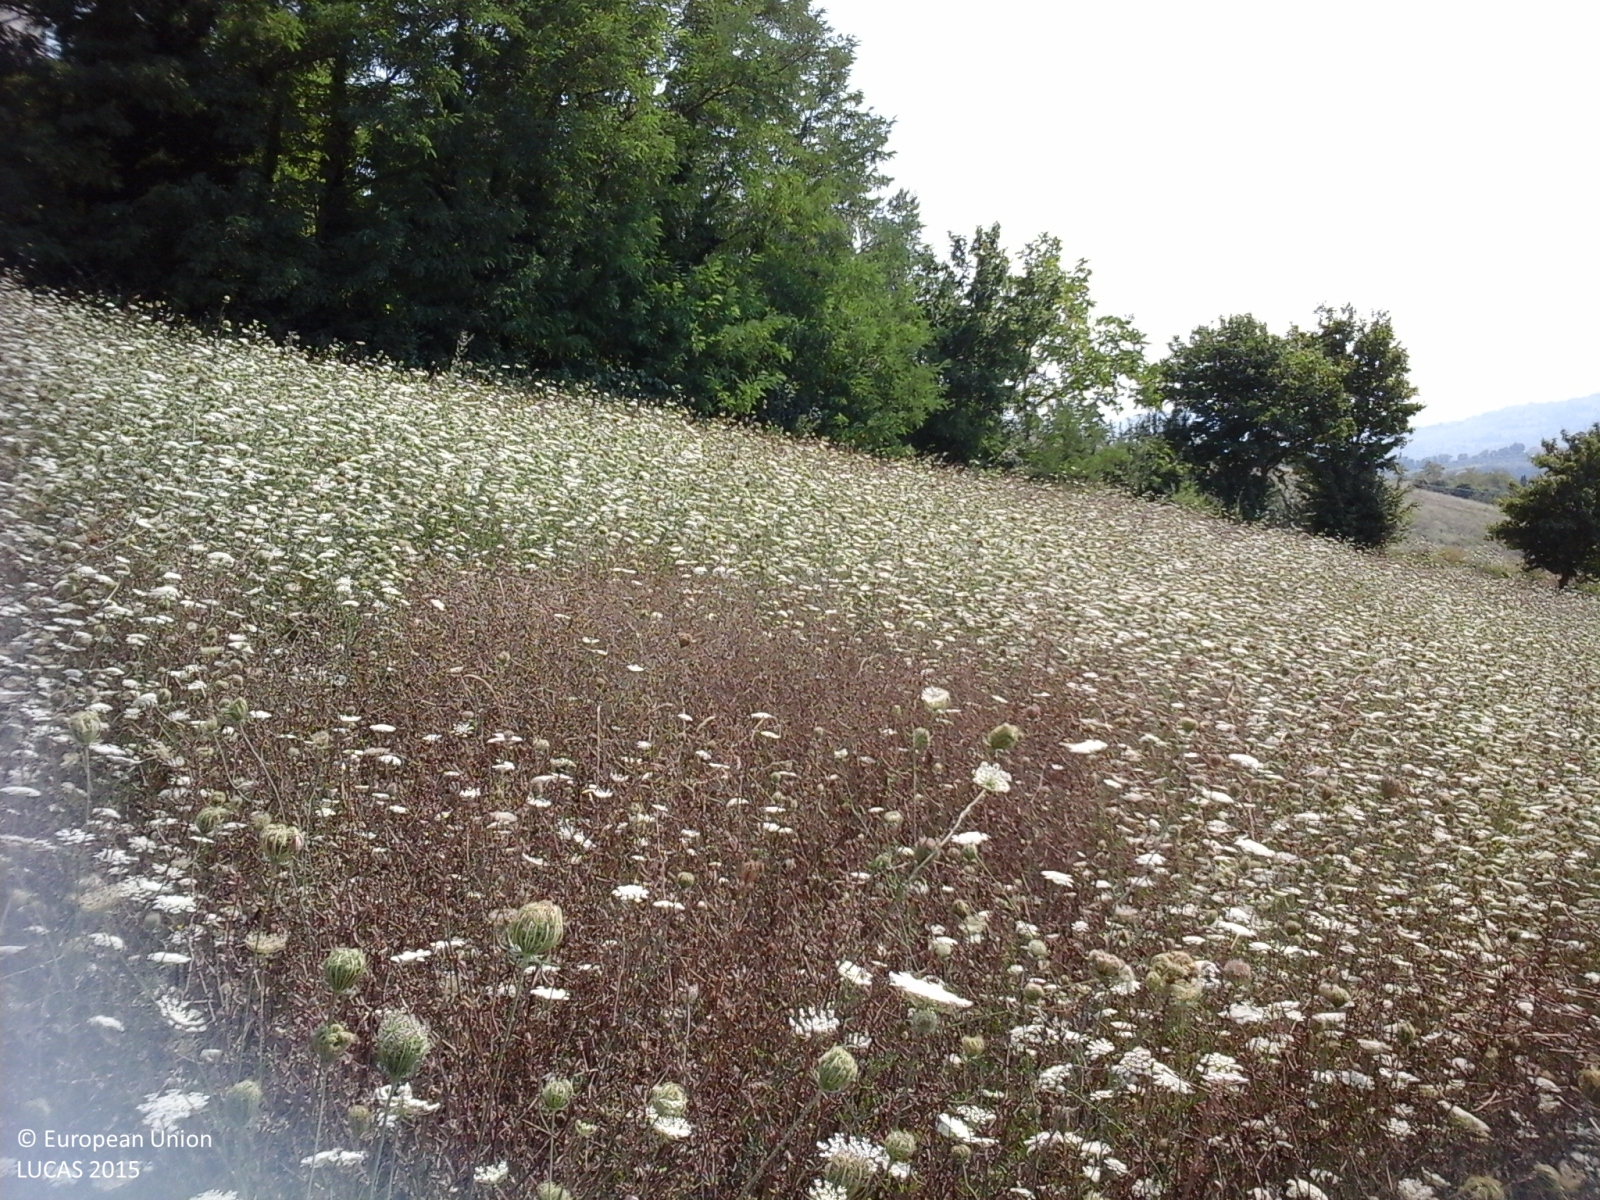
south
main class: Grassland
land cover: Spontaneously vegetated surfaces
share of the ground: > 75 %
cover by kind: herbaceous plants 100 %
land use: Fallow land
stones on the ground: < 10 %
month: August
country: IT
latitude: 43.1007
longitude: 13.4678
